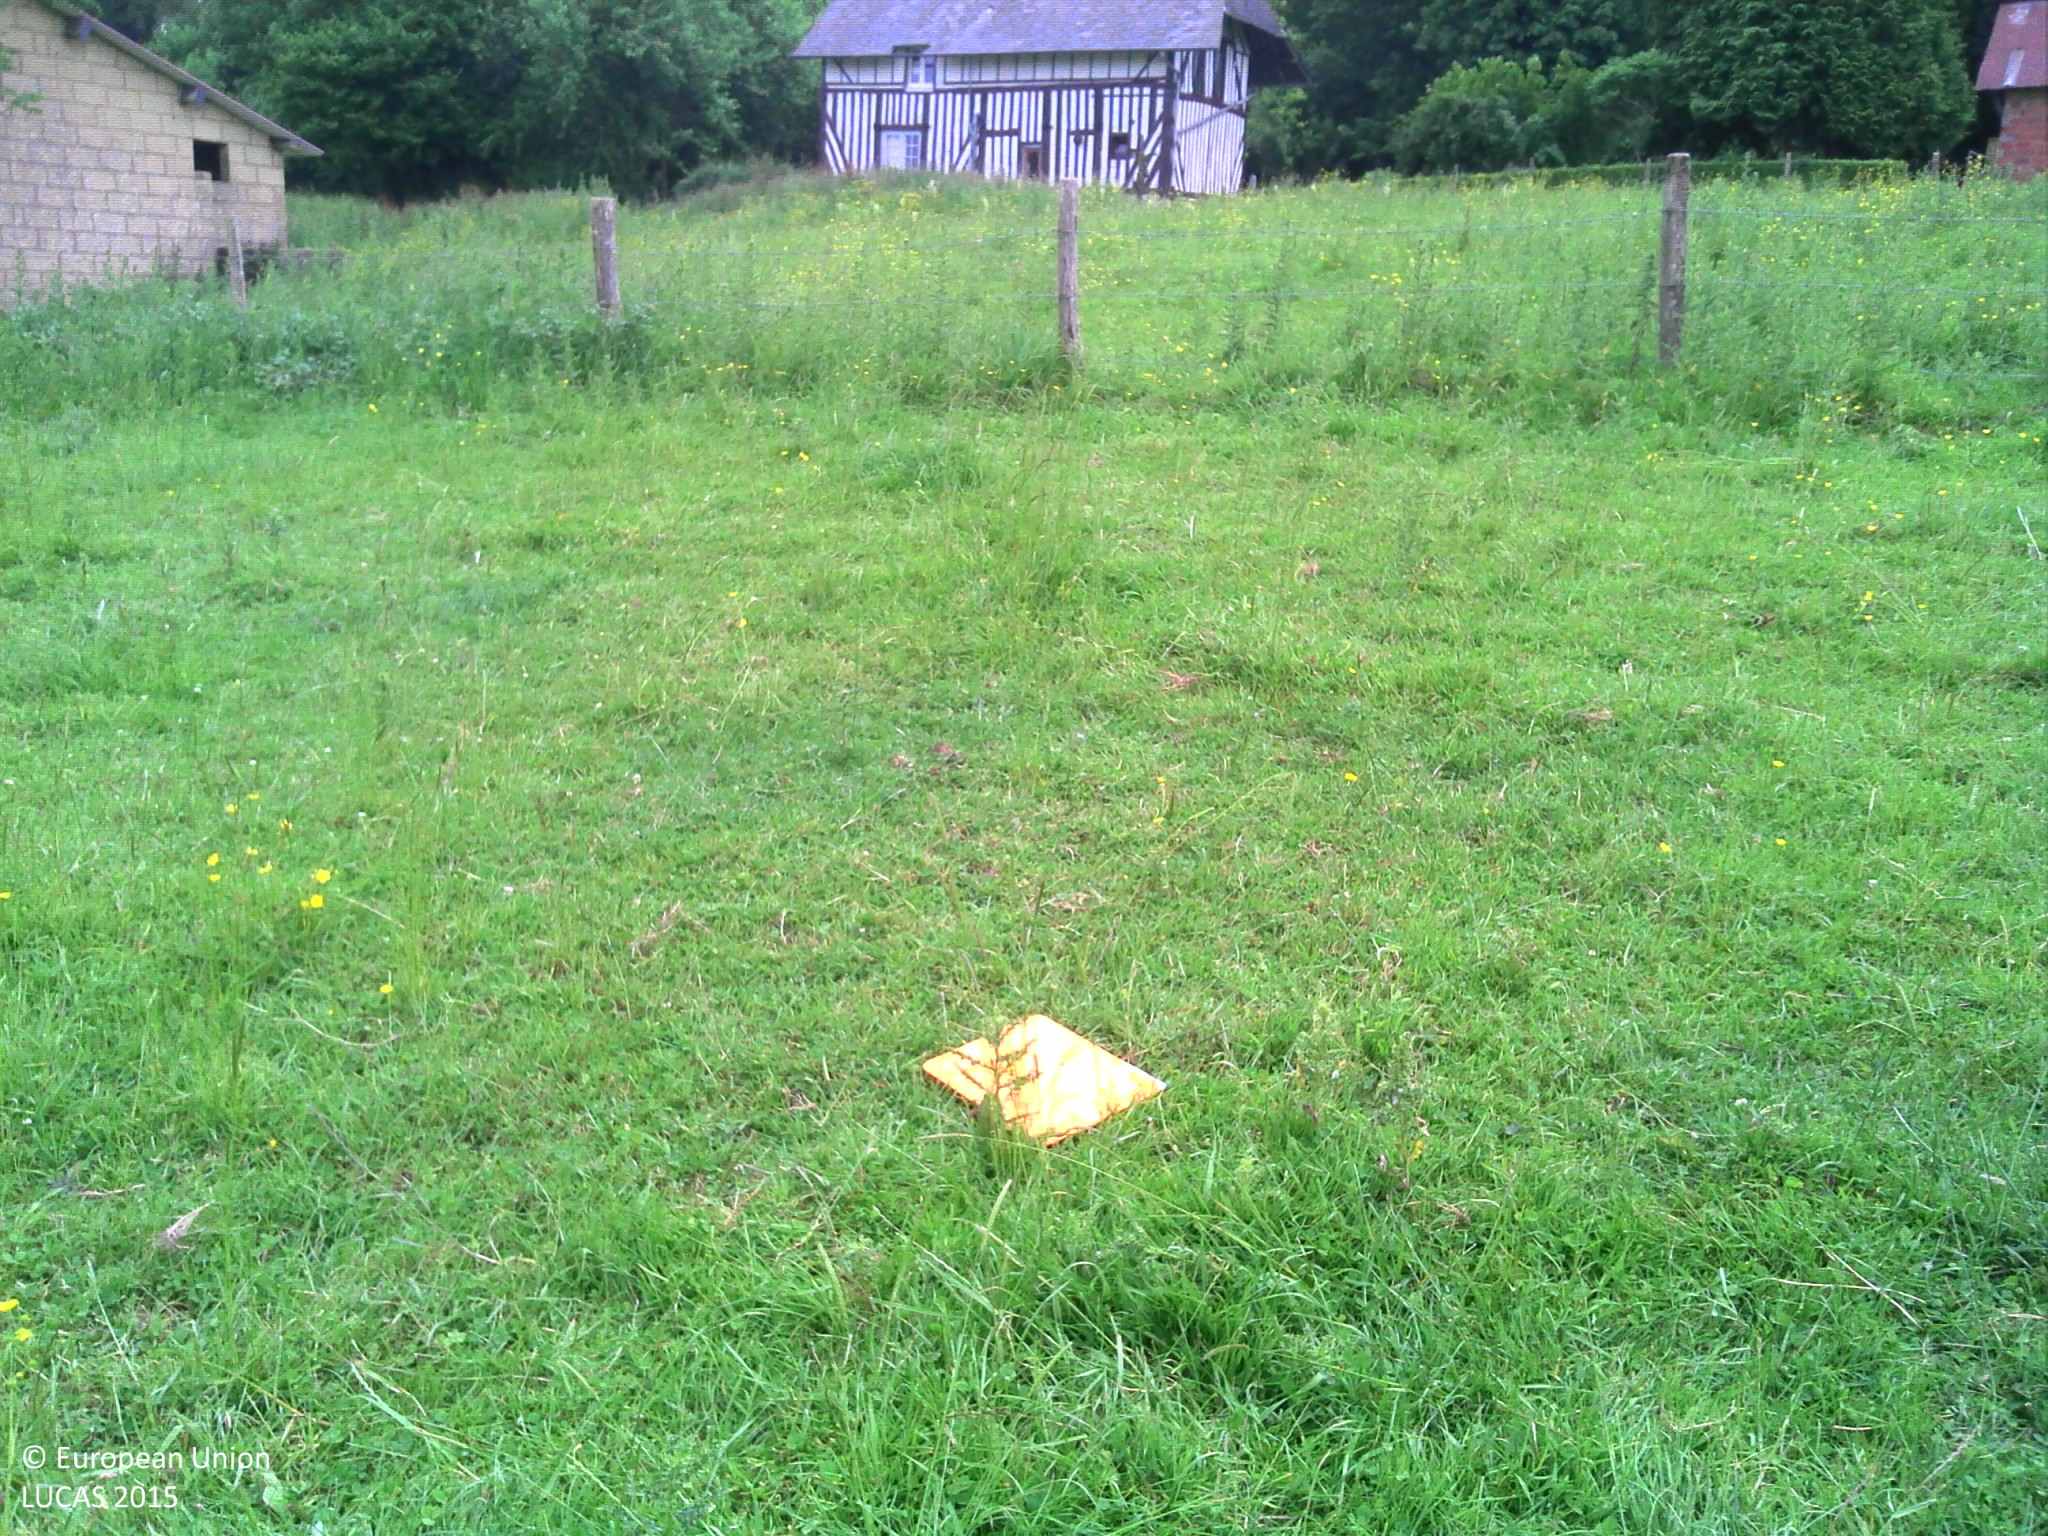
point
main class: Grassland
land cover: Grassland with sparse tree/shrub cover
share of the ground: > 75 %
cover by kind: herbaceous plants 95 %, broadleaved forest trees 5 %
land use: Agriculture (excluding fallow land and kitchen gardens)
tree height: > 5 m
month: June
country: FR
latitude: 49.2193
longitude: 0.0152
